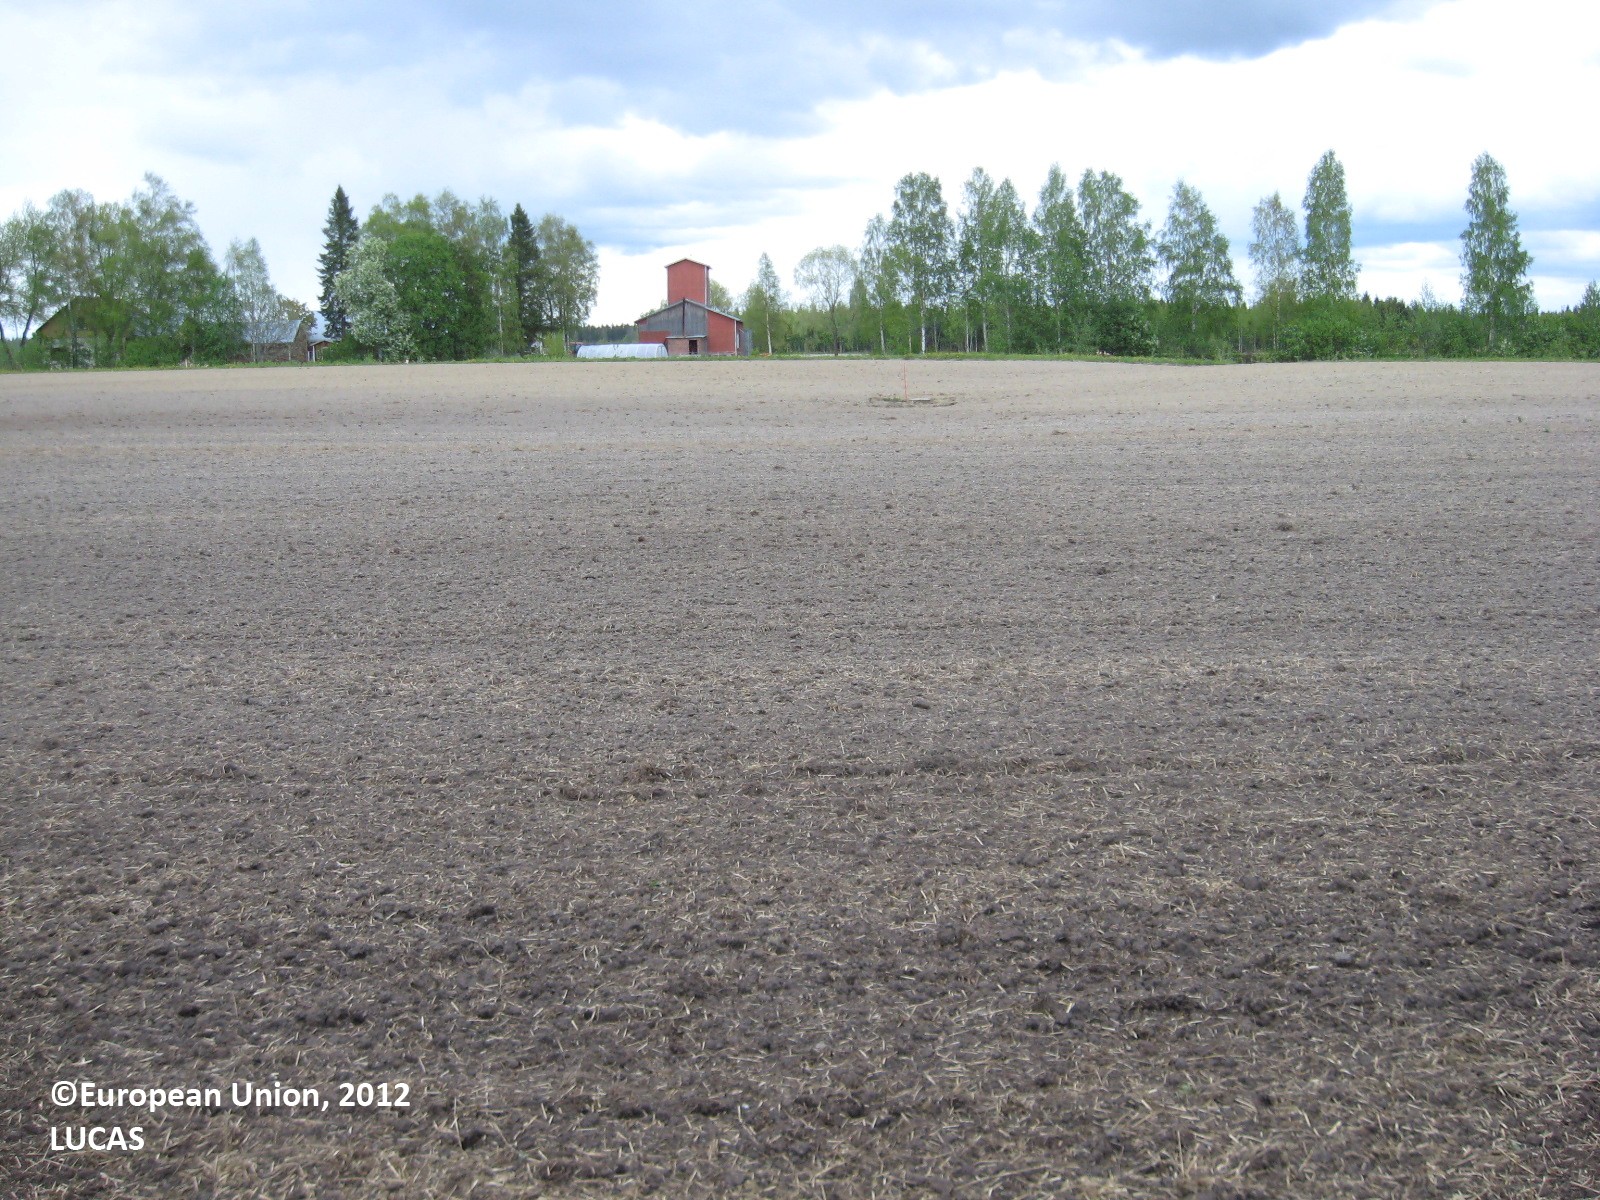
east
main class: Cropland
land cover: Other cereals
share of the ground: < 10 %
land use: Agriculture (excluding fallow land and kitchen gardens)
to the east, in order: Other cereals; Grassland without tree/shrub cover; Spontaneously vegetated surfaces; Inland running water; Broadleaved woodland; Electric lines; Artificial constructions in urban areas; Arable land (only in case pi)
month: May
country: FI
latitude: 61.8311
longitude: 22.3060
